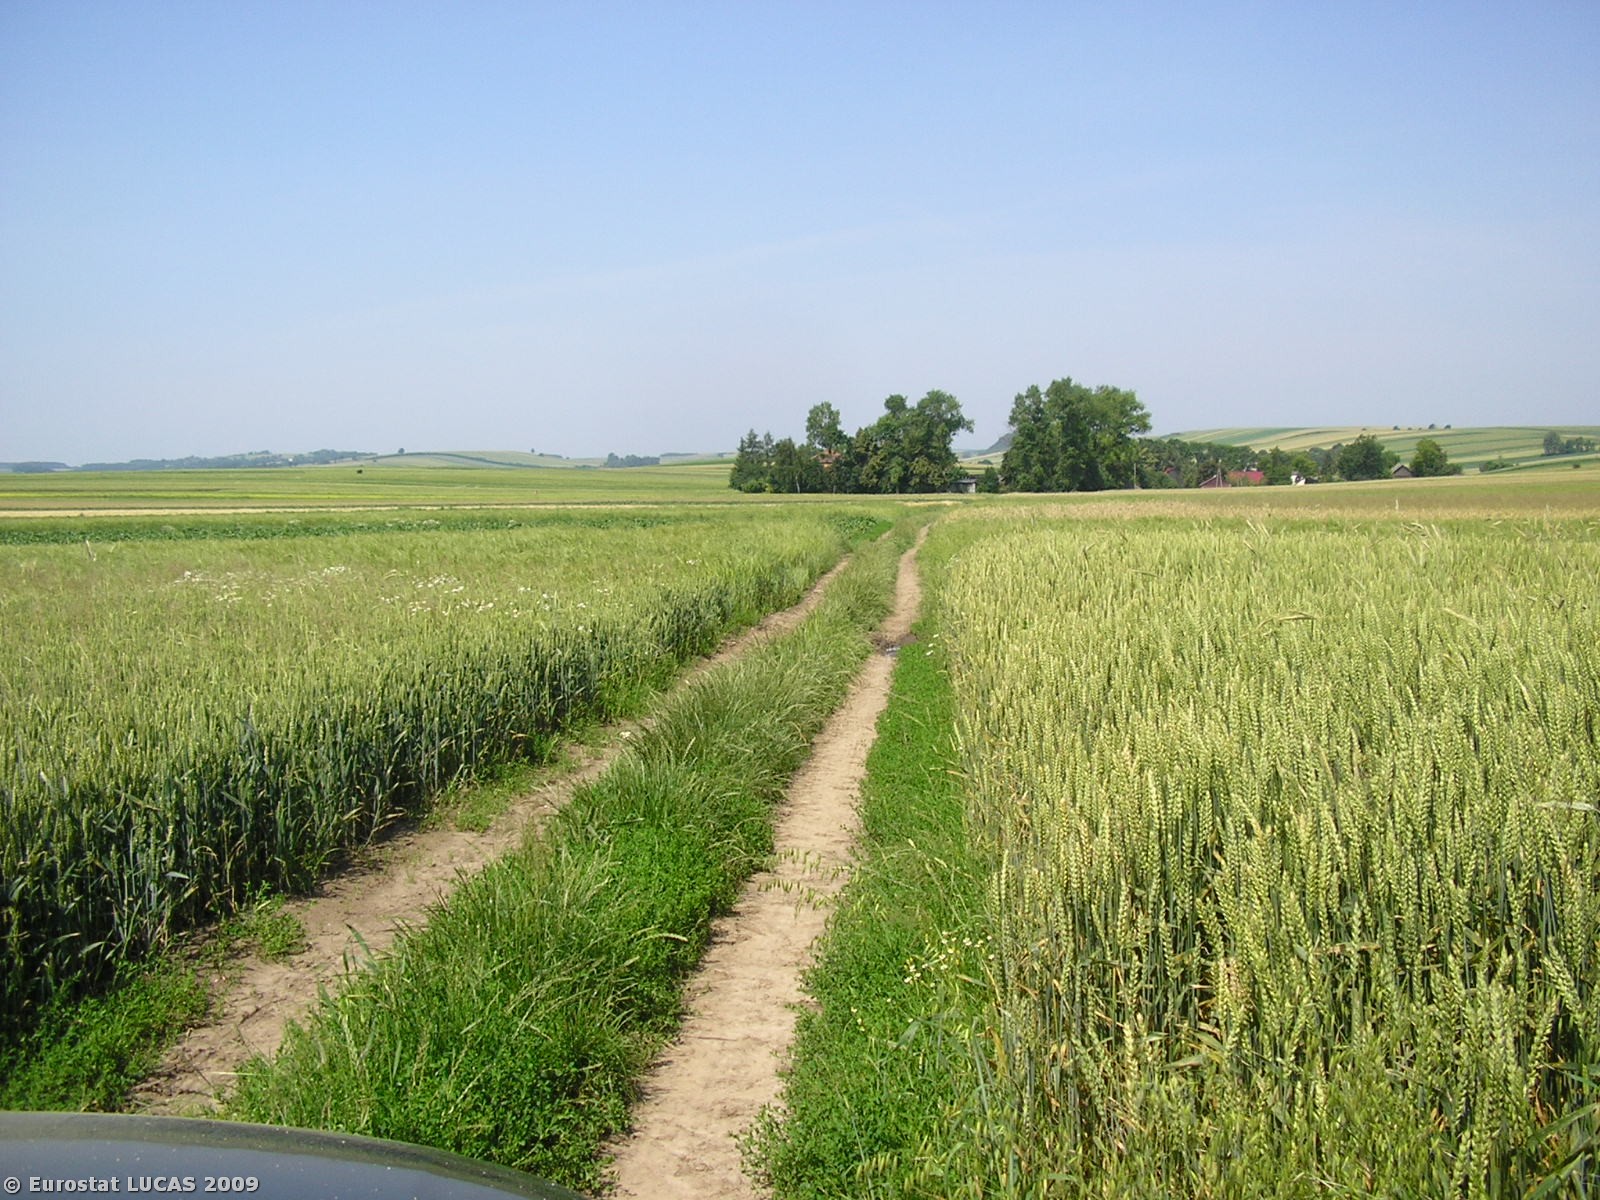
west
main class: Cropland
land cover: Barley
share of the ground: > 75 %
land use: Agriculture (excluding fallow land and kitchen gardens)
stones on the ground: < 10 %
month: June
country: PL
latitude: 50.3705
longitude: 20.2851
